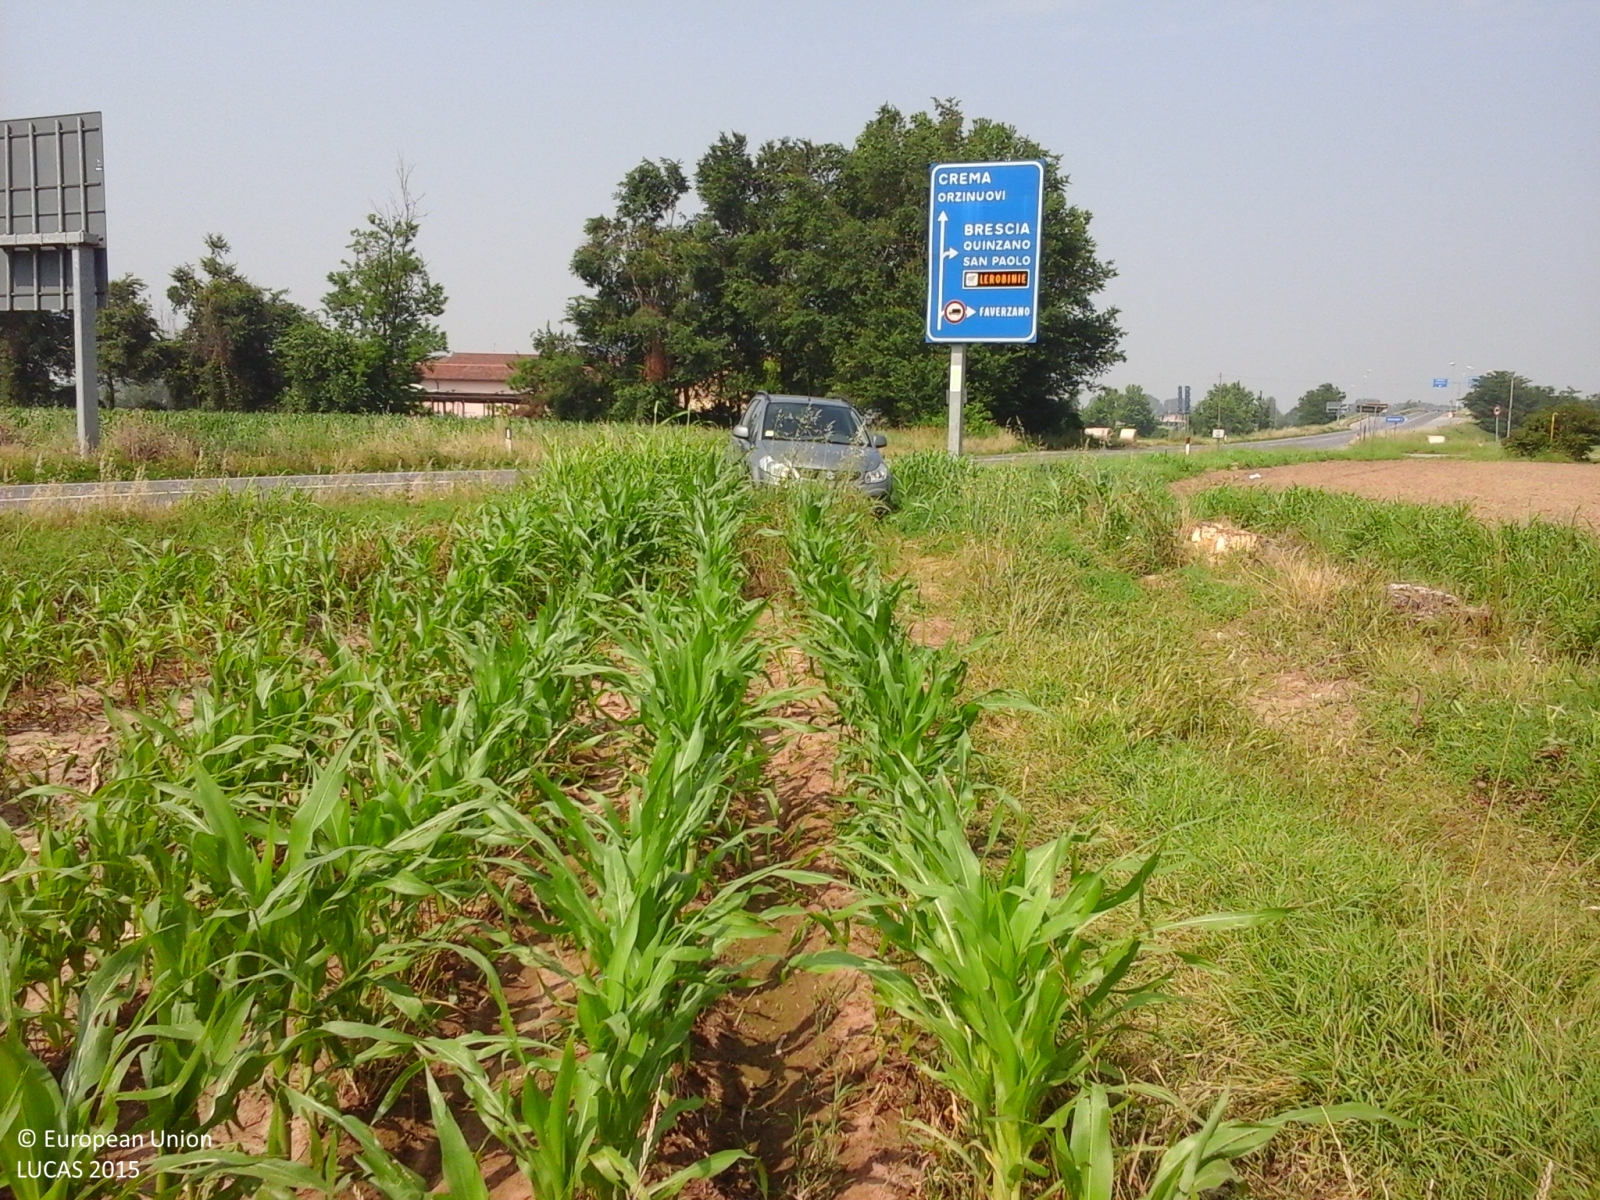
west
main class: Cropland
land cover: Maize
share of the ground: > 75 %
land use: Agriculture (excluding fallow land and kitchen gardens)
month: June
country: IT
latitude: 45.3782
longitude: 10.0637
